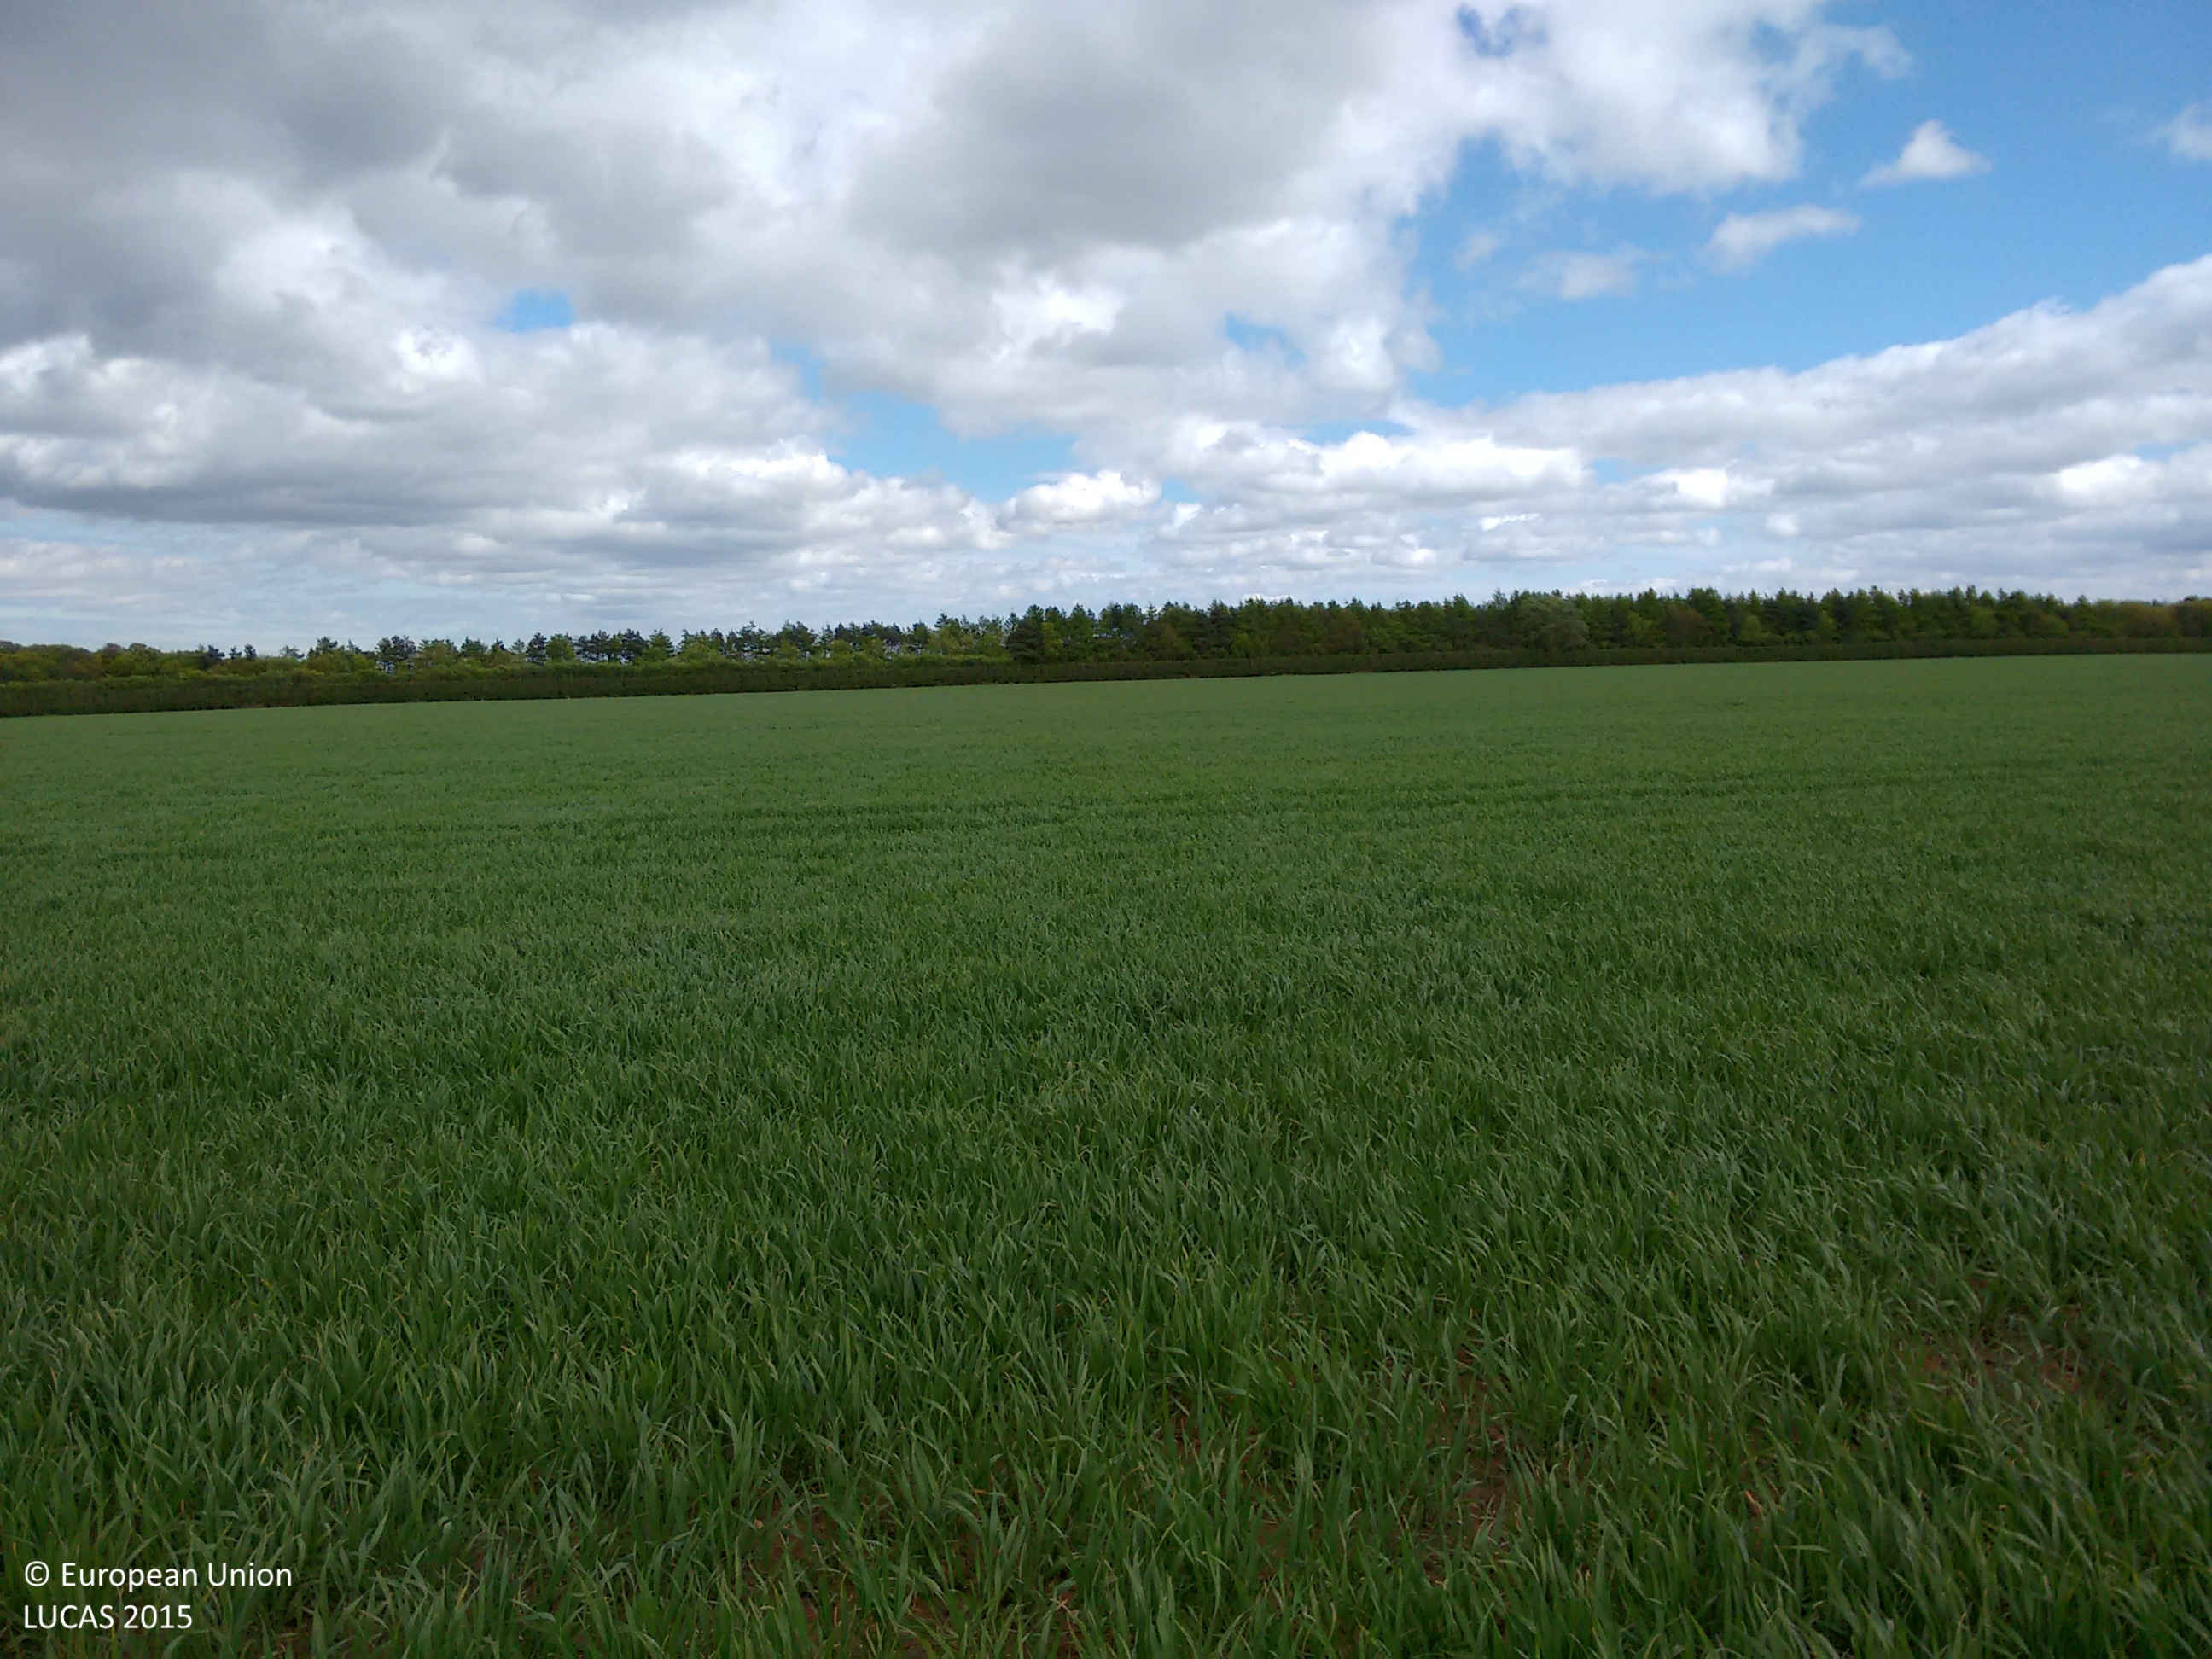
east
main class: Cropland
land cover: Common wheat
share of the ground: > 75 %
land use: Agriculture (excluding fallow land and kitchen gardens)
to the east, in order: Common wheat
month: May
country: GB
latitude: 53.8349
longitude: -0.4759
